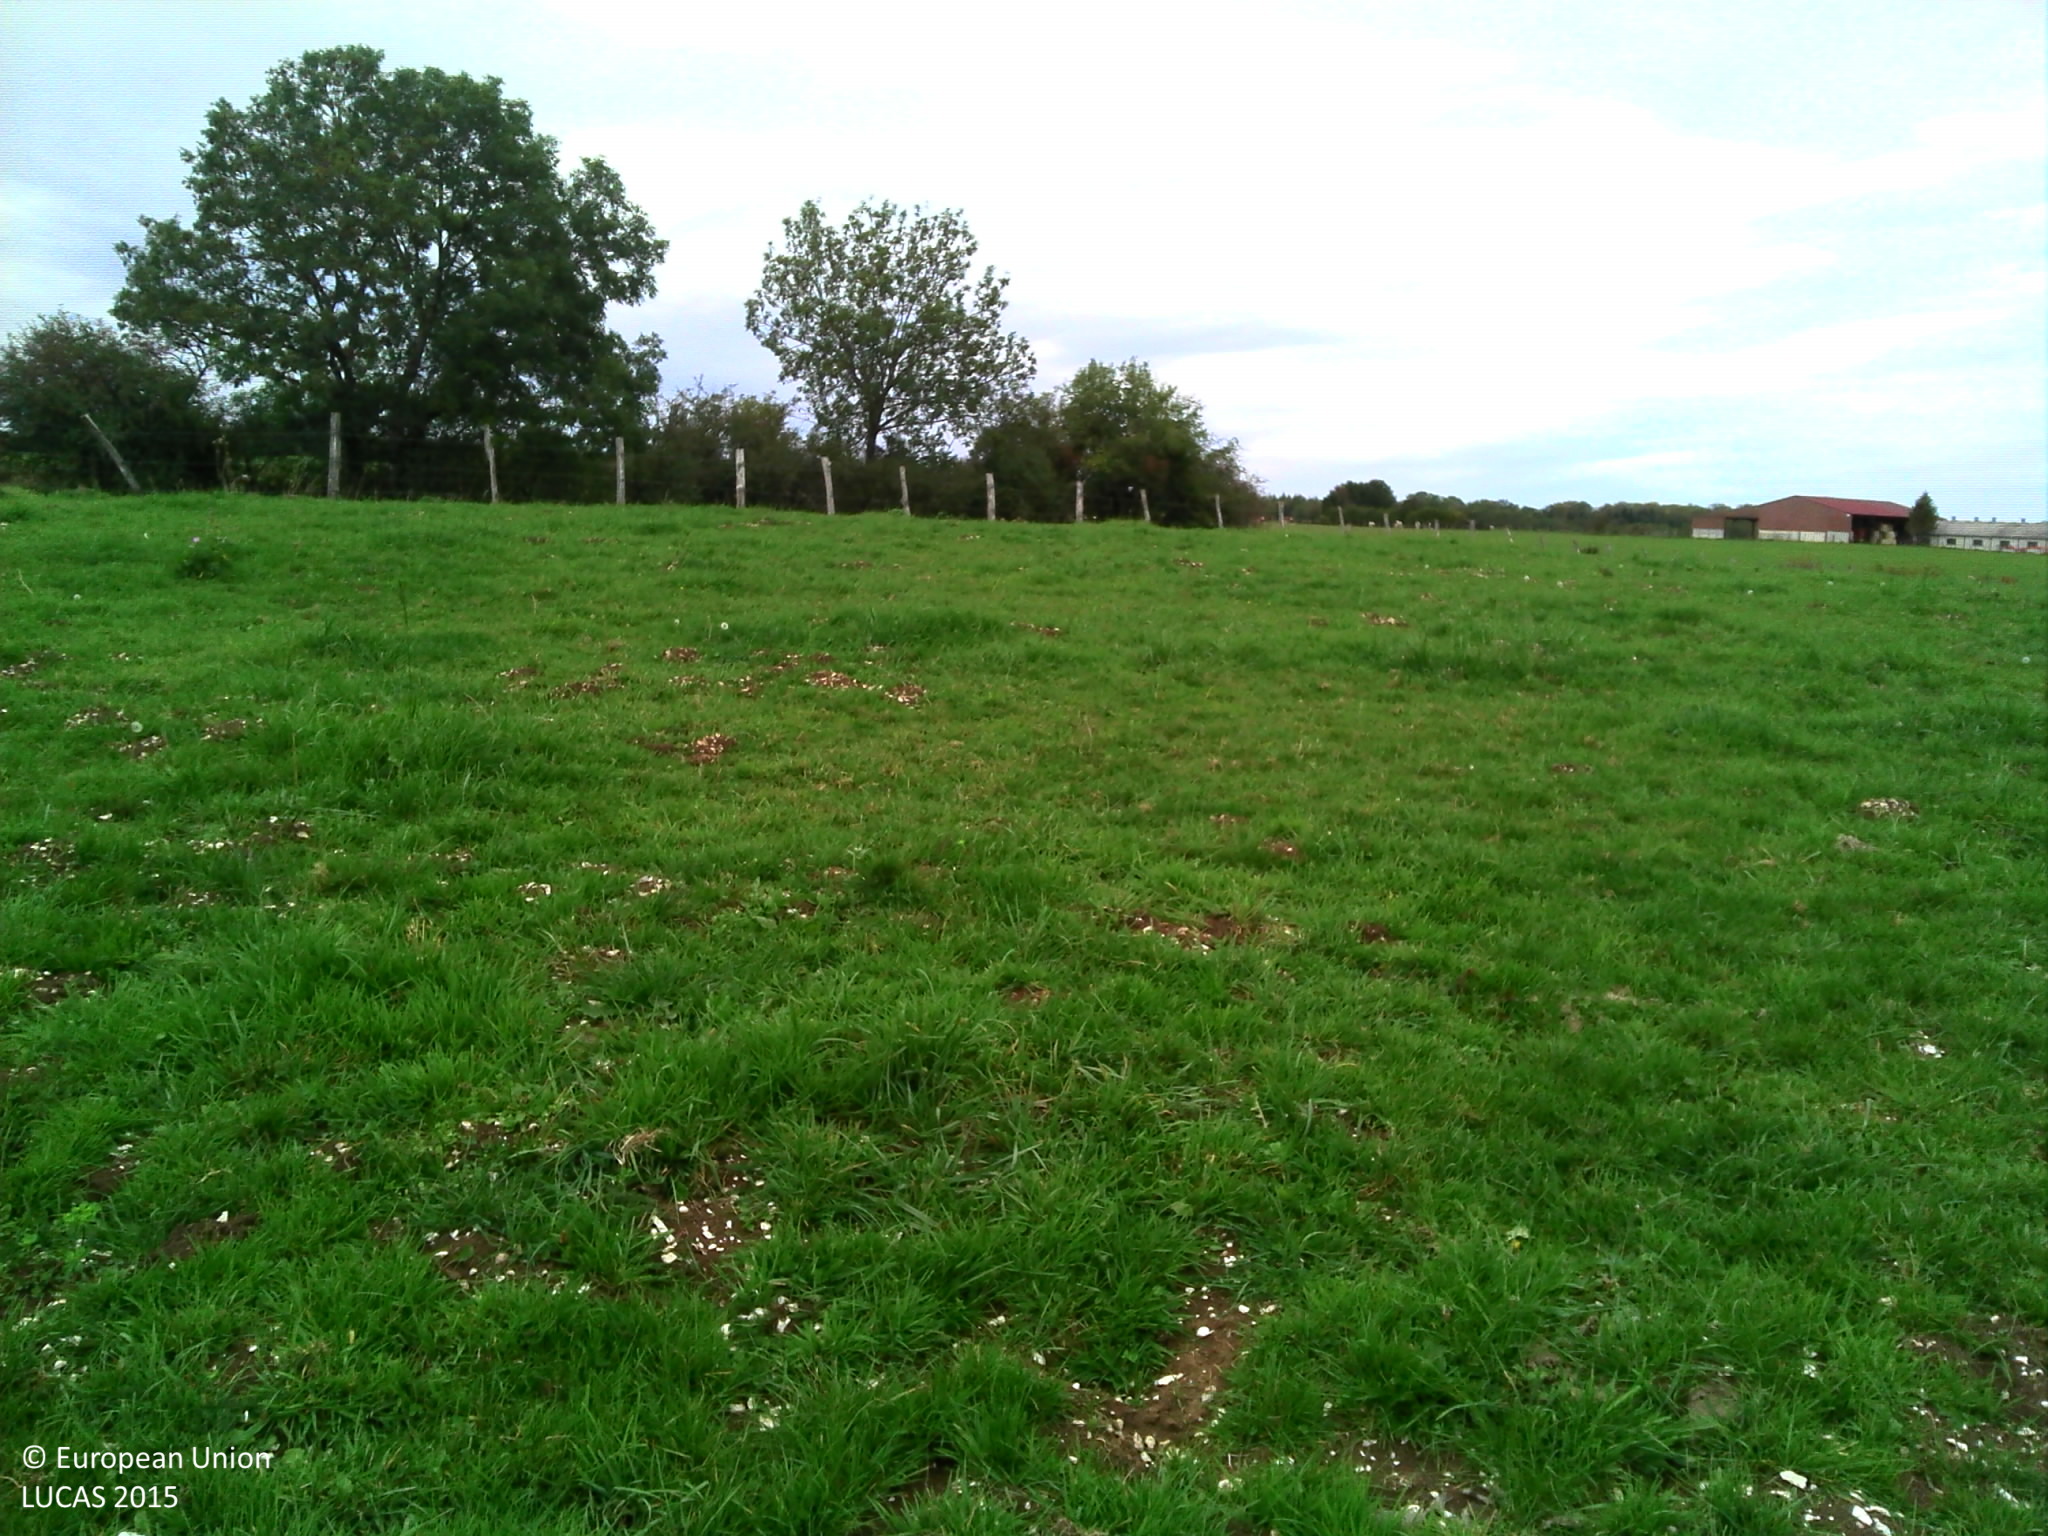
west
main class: Grassland
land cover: Grassland without tree/shrub cover
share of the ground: > 75 %
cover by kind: herbaceous plants 100 %
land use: Agriculture (excluding fallow land and kitchen gardens)
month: October
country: FR
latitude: 47.0390
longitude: 6.1460
